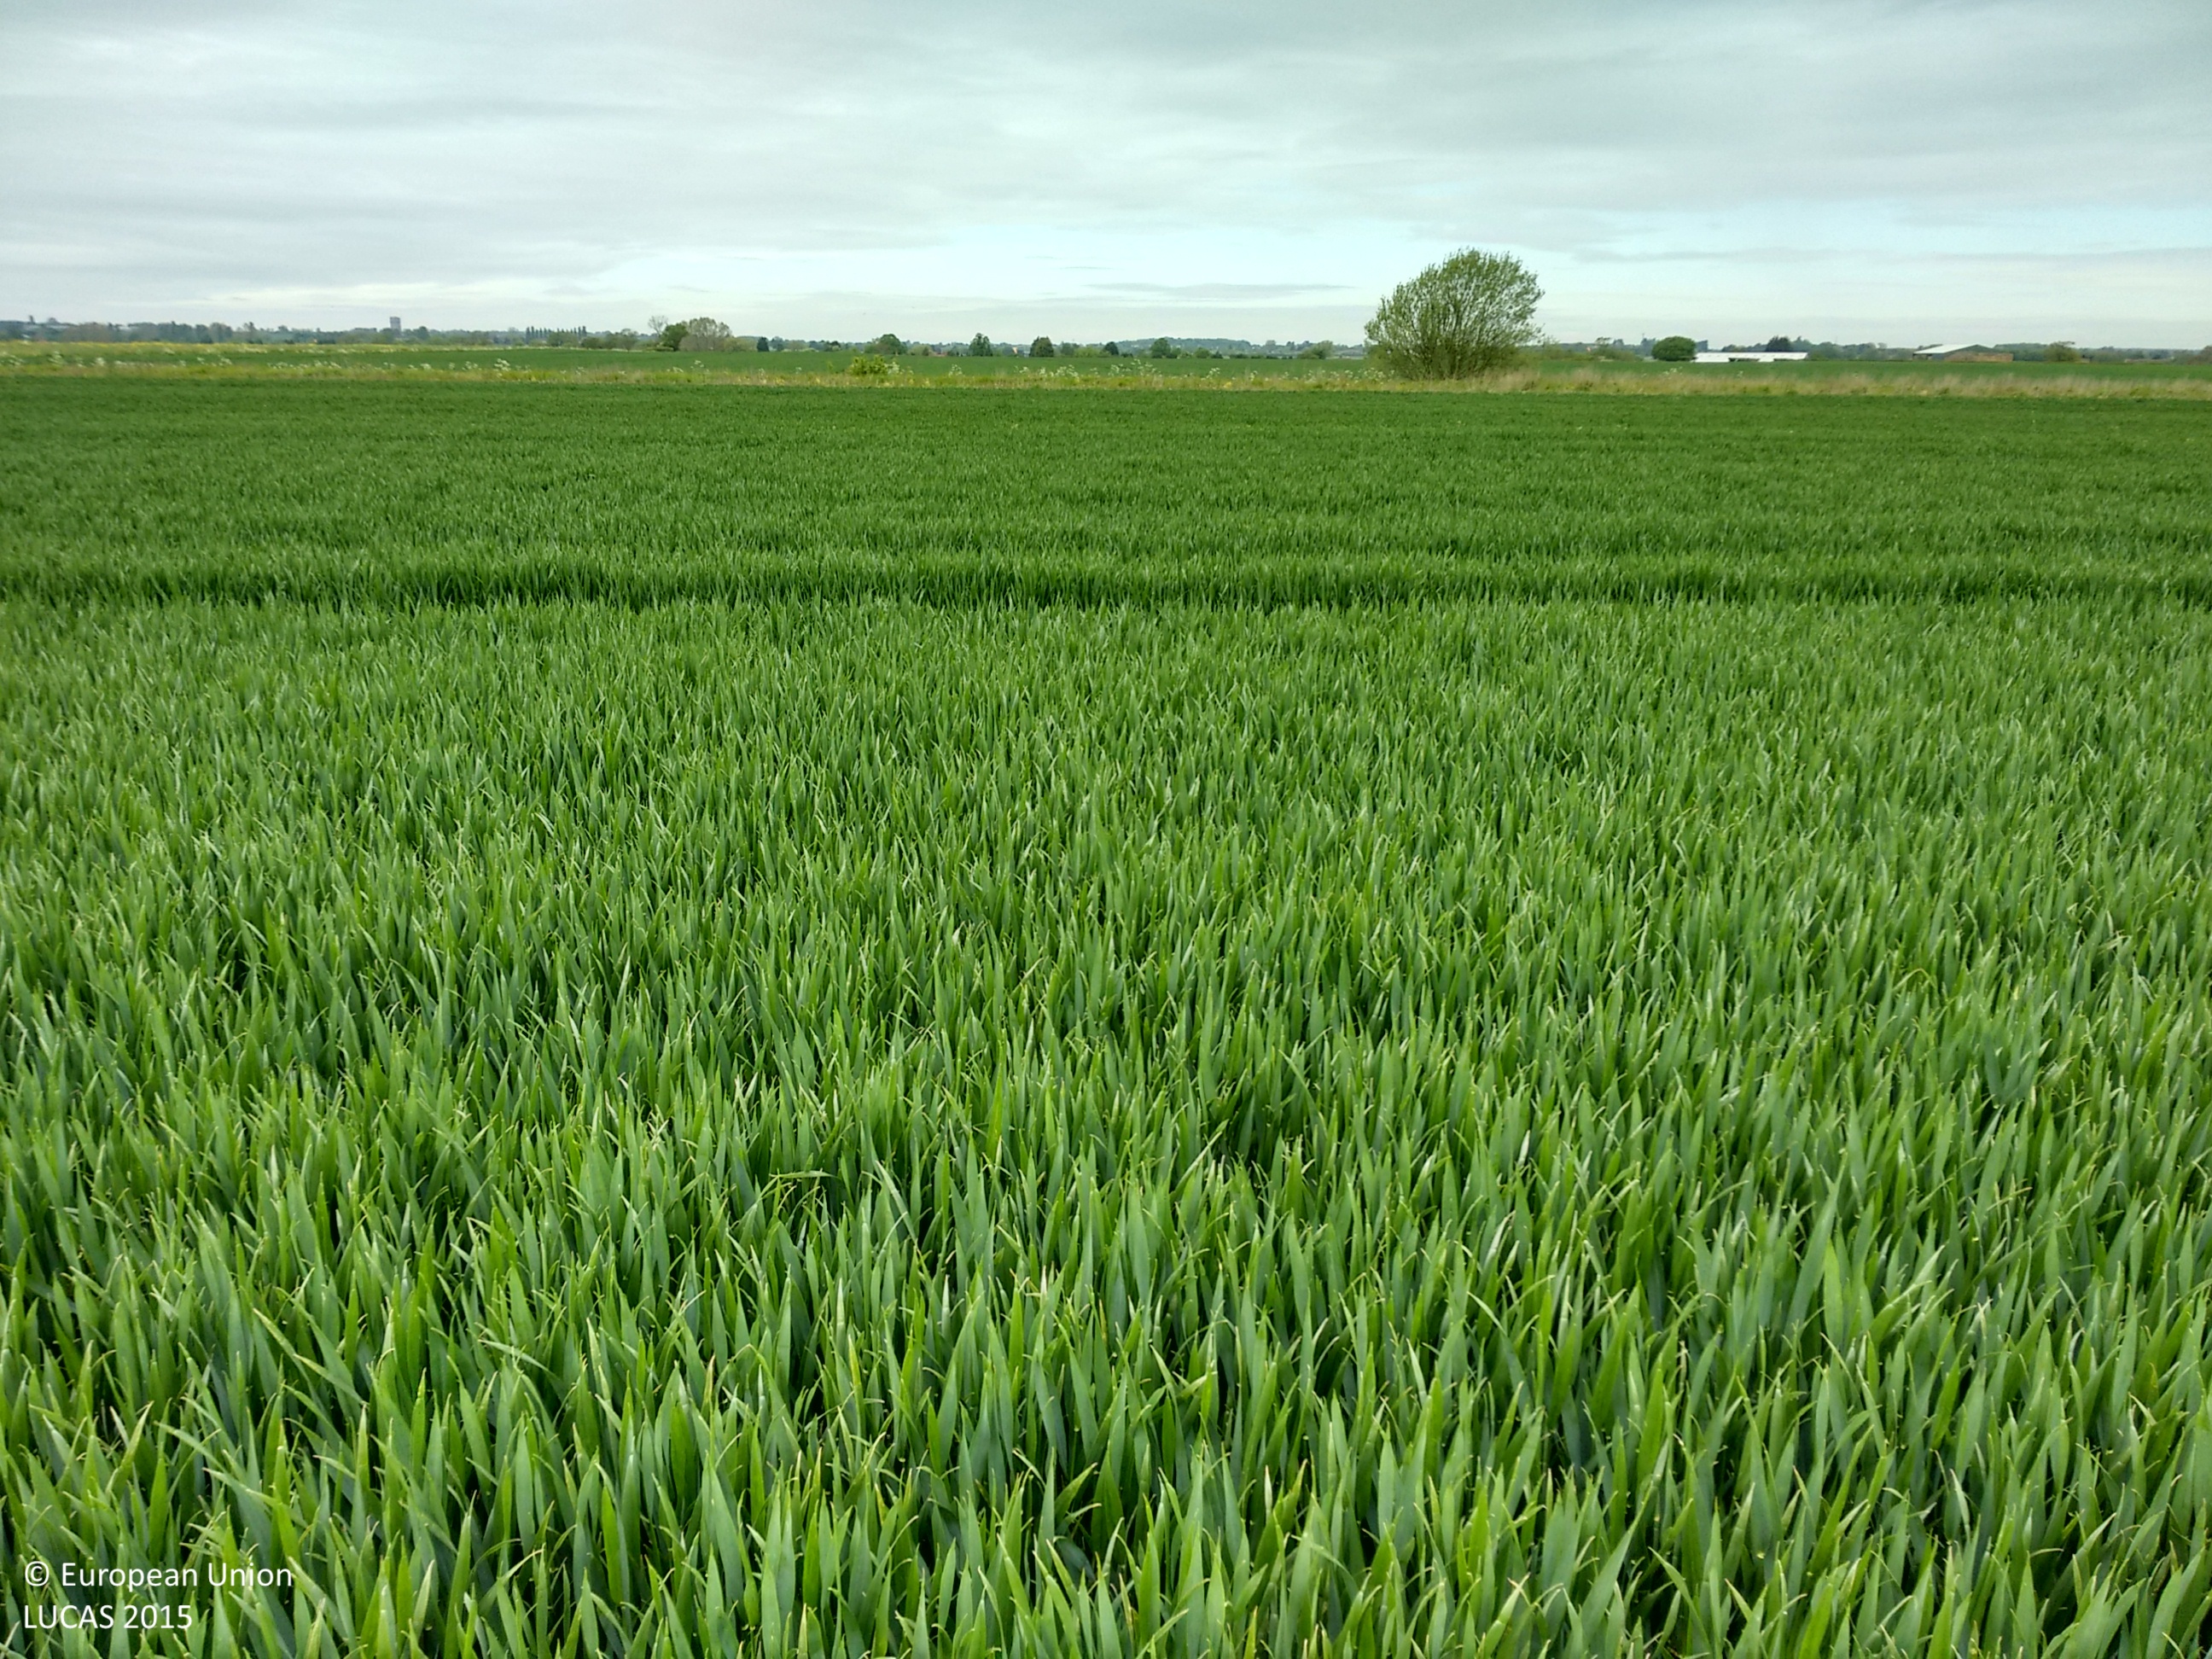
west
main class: Cropland
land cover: Barley
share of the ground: > 75 %
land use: Agriculture (excluding fallow land and kitchen gardens)
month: May
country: GB
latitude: 52.0206
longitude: -0.2803
